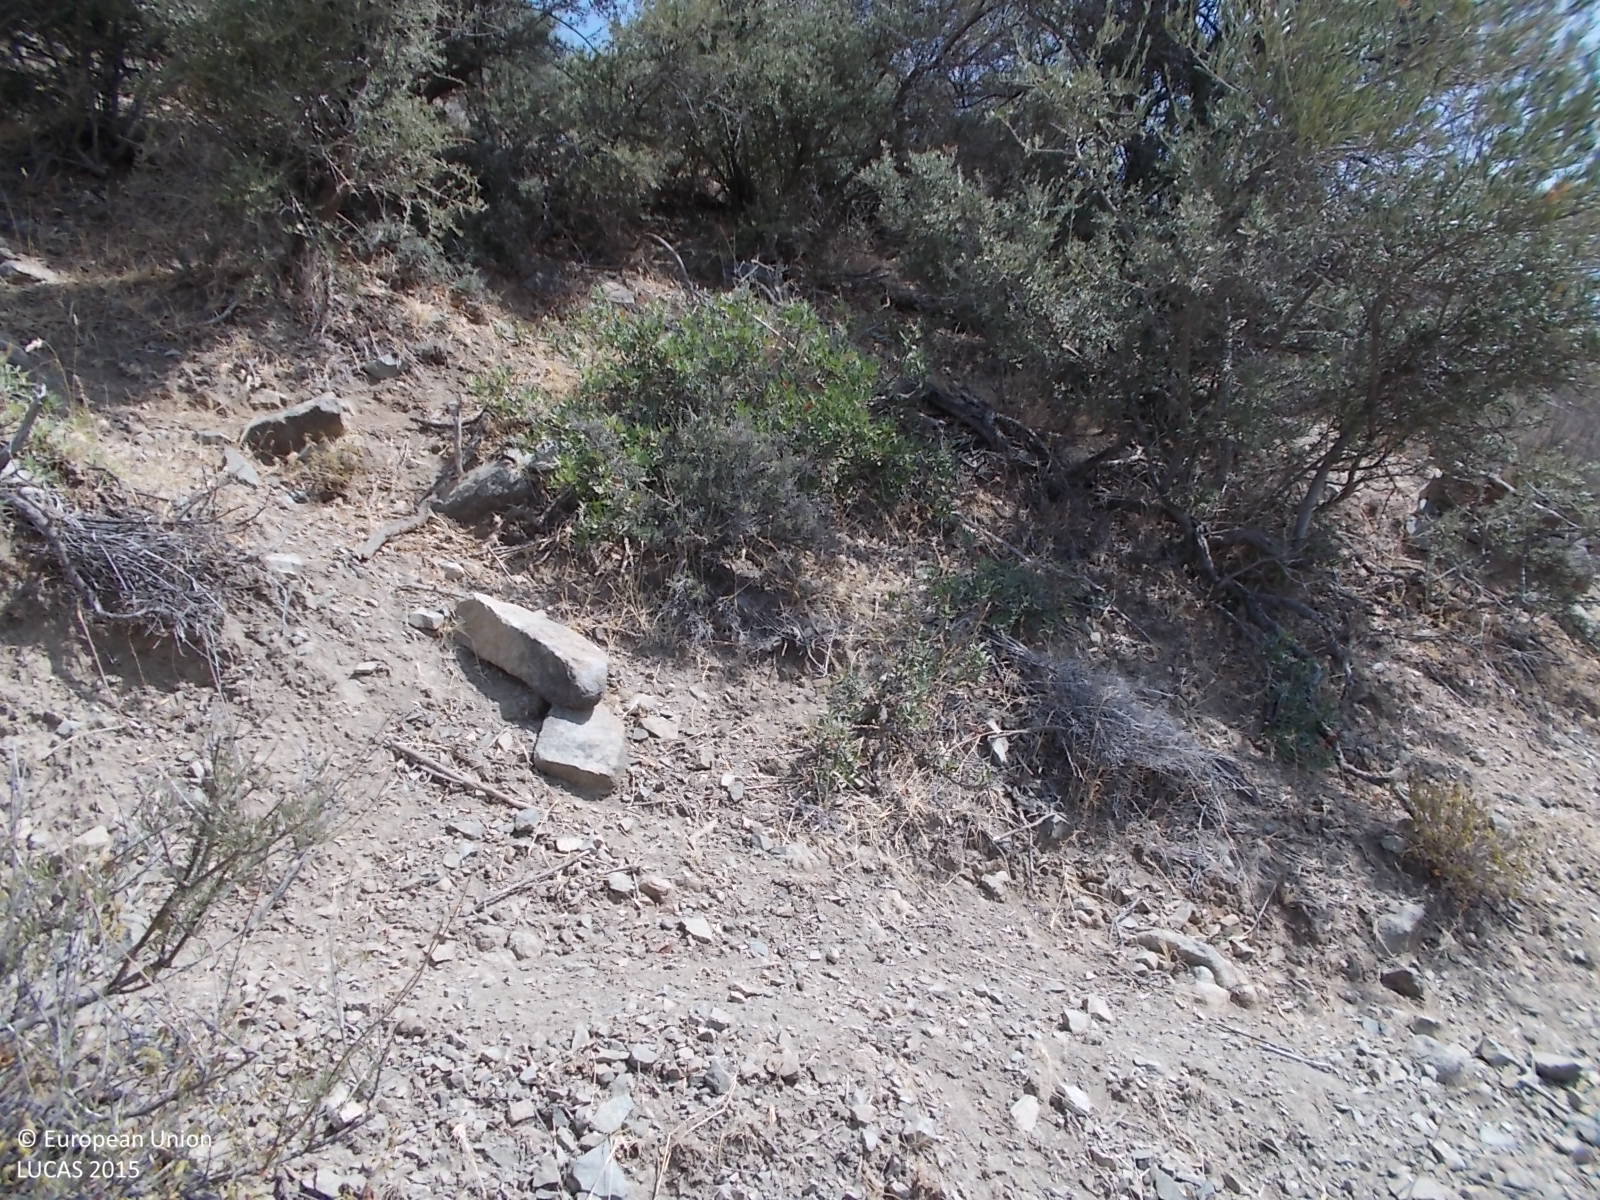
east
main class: Woodland
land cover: Pine dominated mixed woodland
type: coniferous forest of the mediterranean region
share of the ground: 50 - 75 %
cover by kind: coniferous forest trees 40 %, unconsolidated bare surface 35 %, broadleaved forest trees 15 %, shrubs 10 %
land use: Semi-natural and natural areas not in use
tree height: > 5 m
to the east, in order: Pine dominated mixed woodland; Shrubland with sparse tree cover; Pine dominated mixed woodland; Shrubland without tree cover; Tracks; Shrubland without tree cover; Tracks; Shrubland without tree cover; Tracks; Shrubland with sparse tree cover
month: April
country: CY
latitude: 34.8540
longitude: 33.1316
